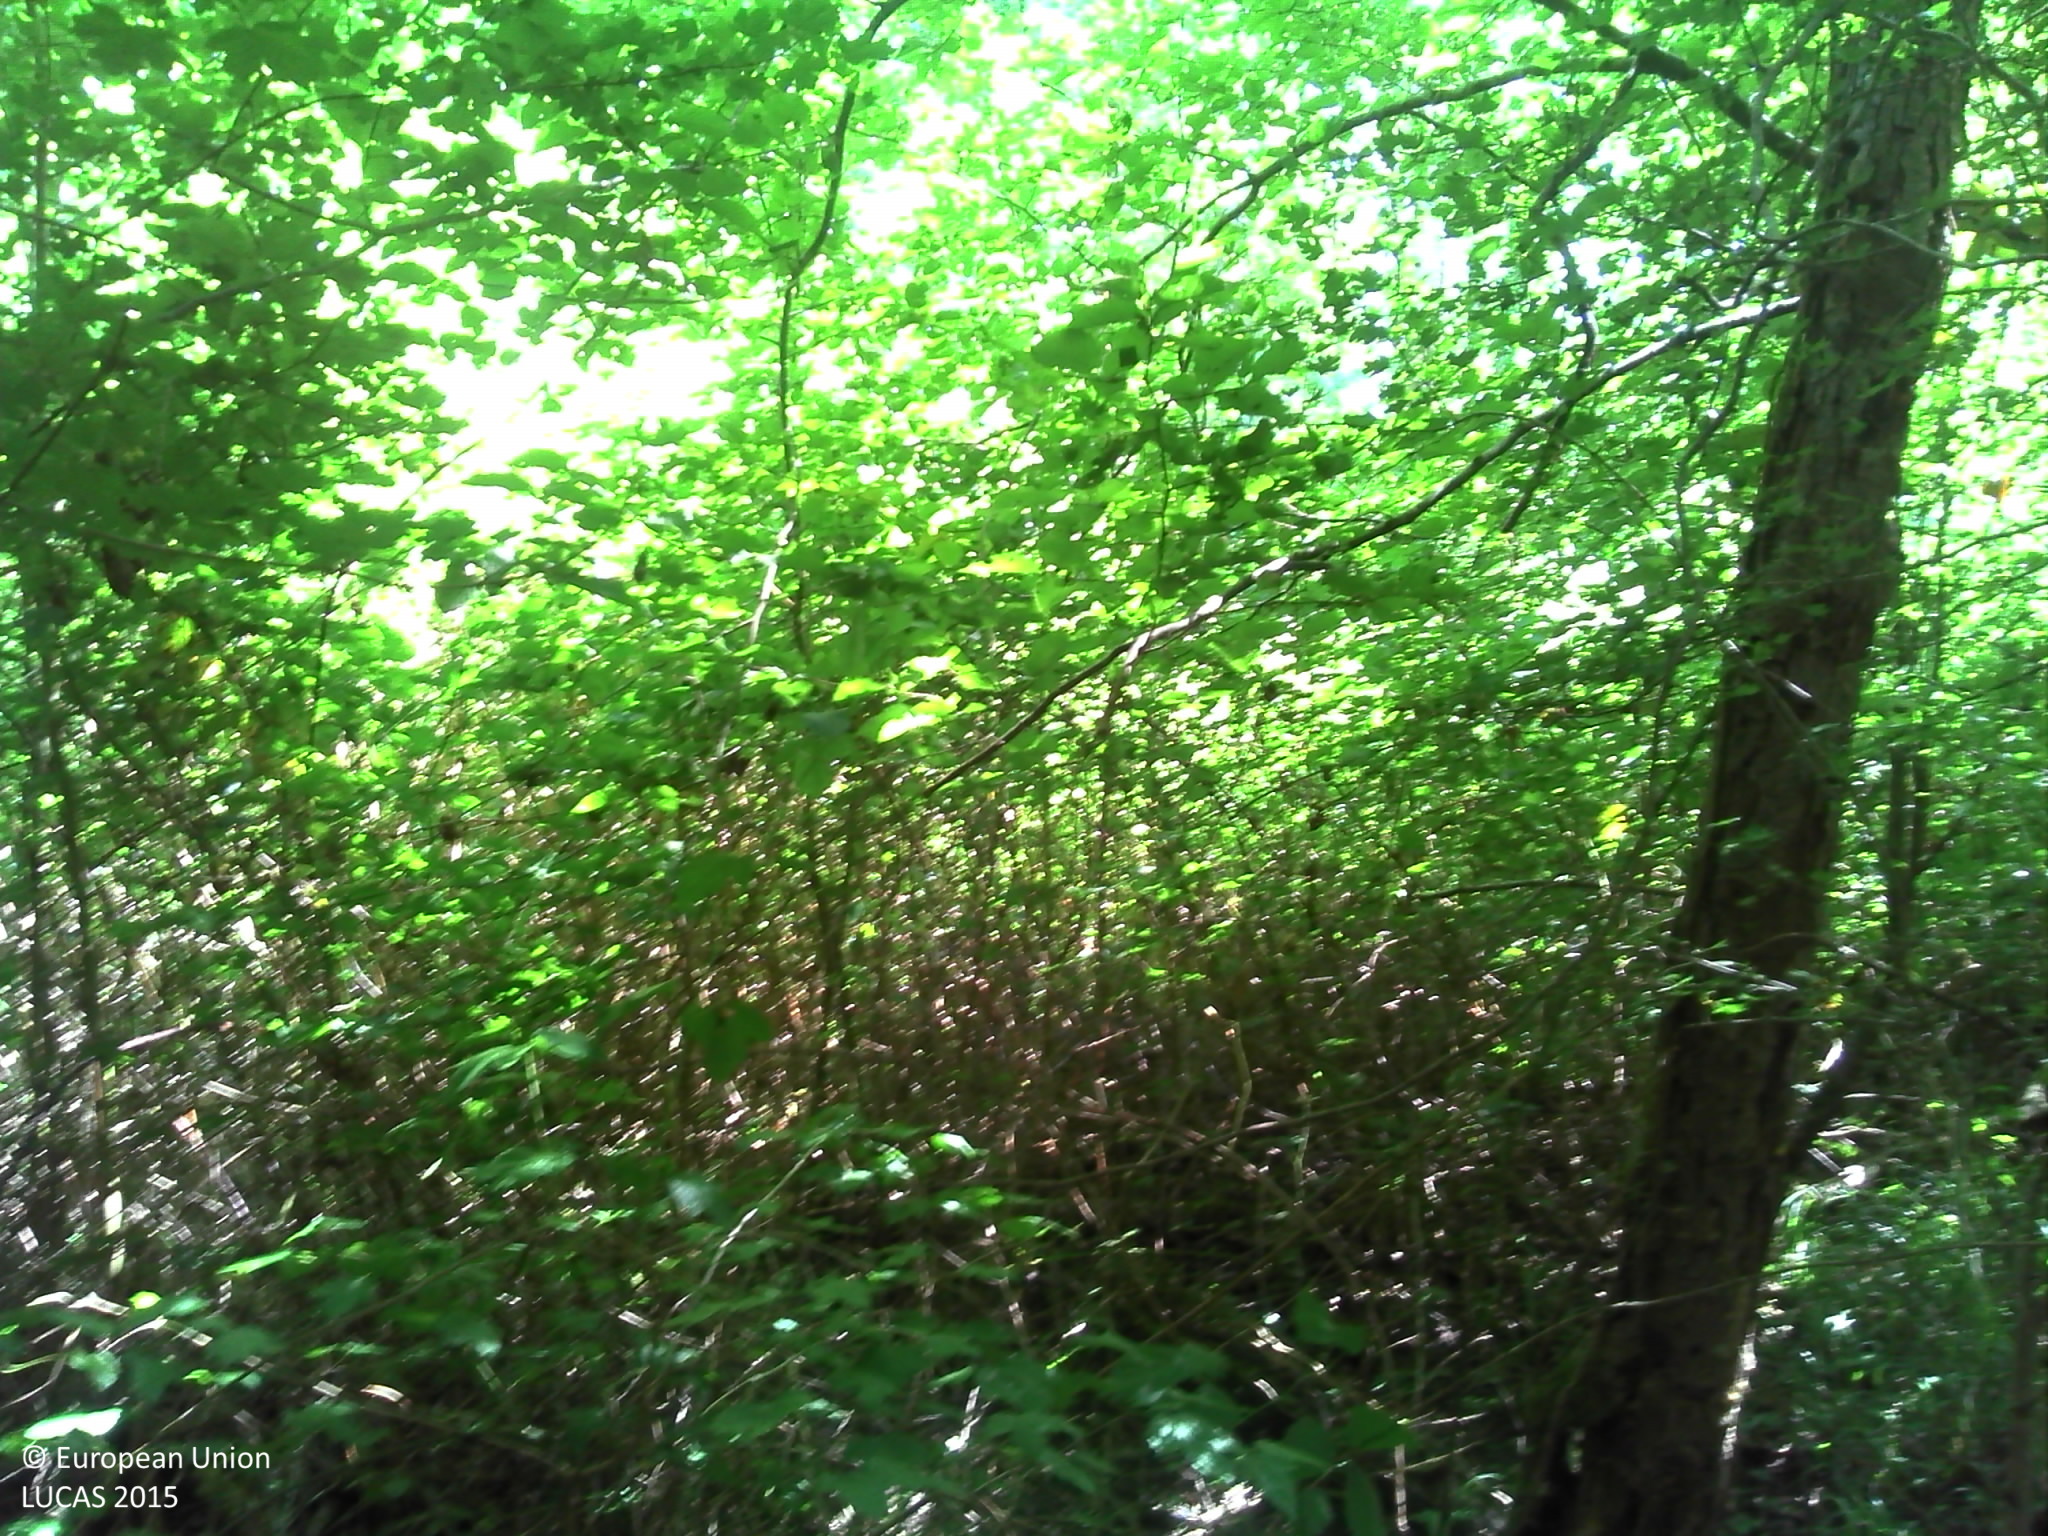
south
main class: Woodland
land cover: Broadleaved woodland
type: acidophilous oak and oak-birch forest
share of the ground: > 75 %
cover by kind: broadleaved forest trees 100 %
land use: Forestry
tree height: > 5 m
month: June
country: FR
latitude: 47.5744
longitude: 2.5607
